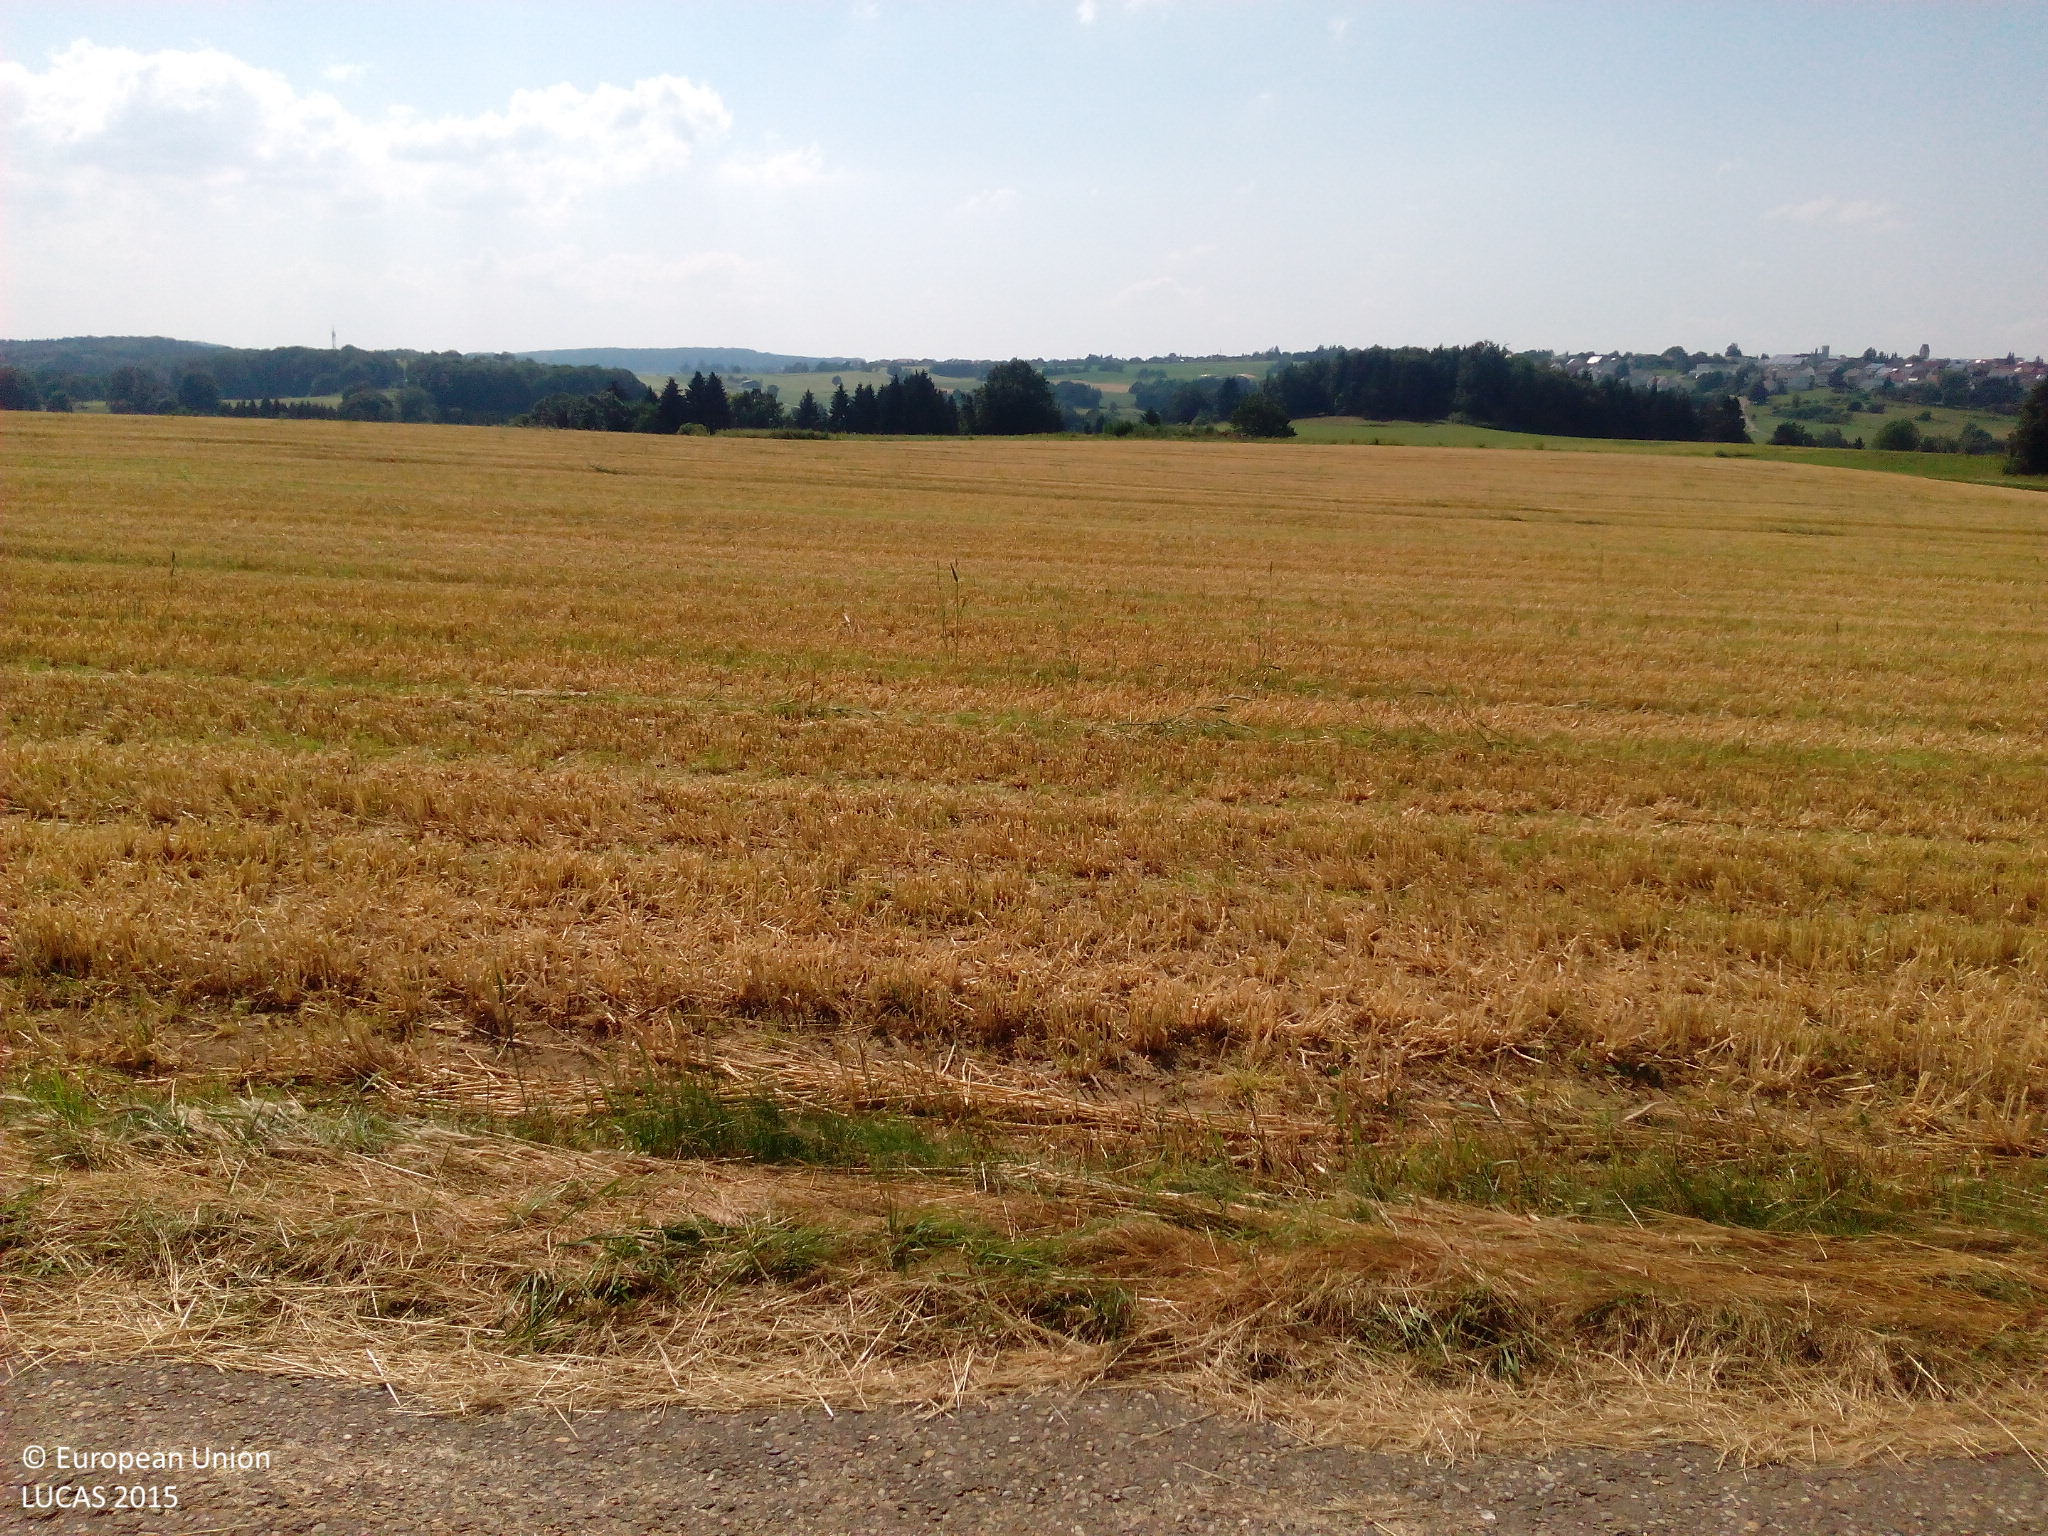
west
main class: Cropland
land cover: Barley
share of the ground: > 75 %
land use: Agriculture (excluding fallow land and kitchen gardens)
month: July
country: DE
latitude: 48.4390
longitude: 9.6893
